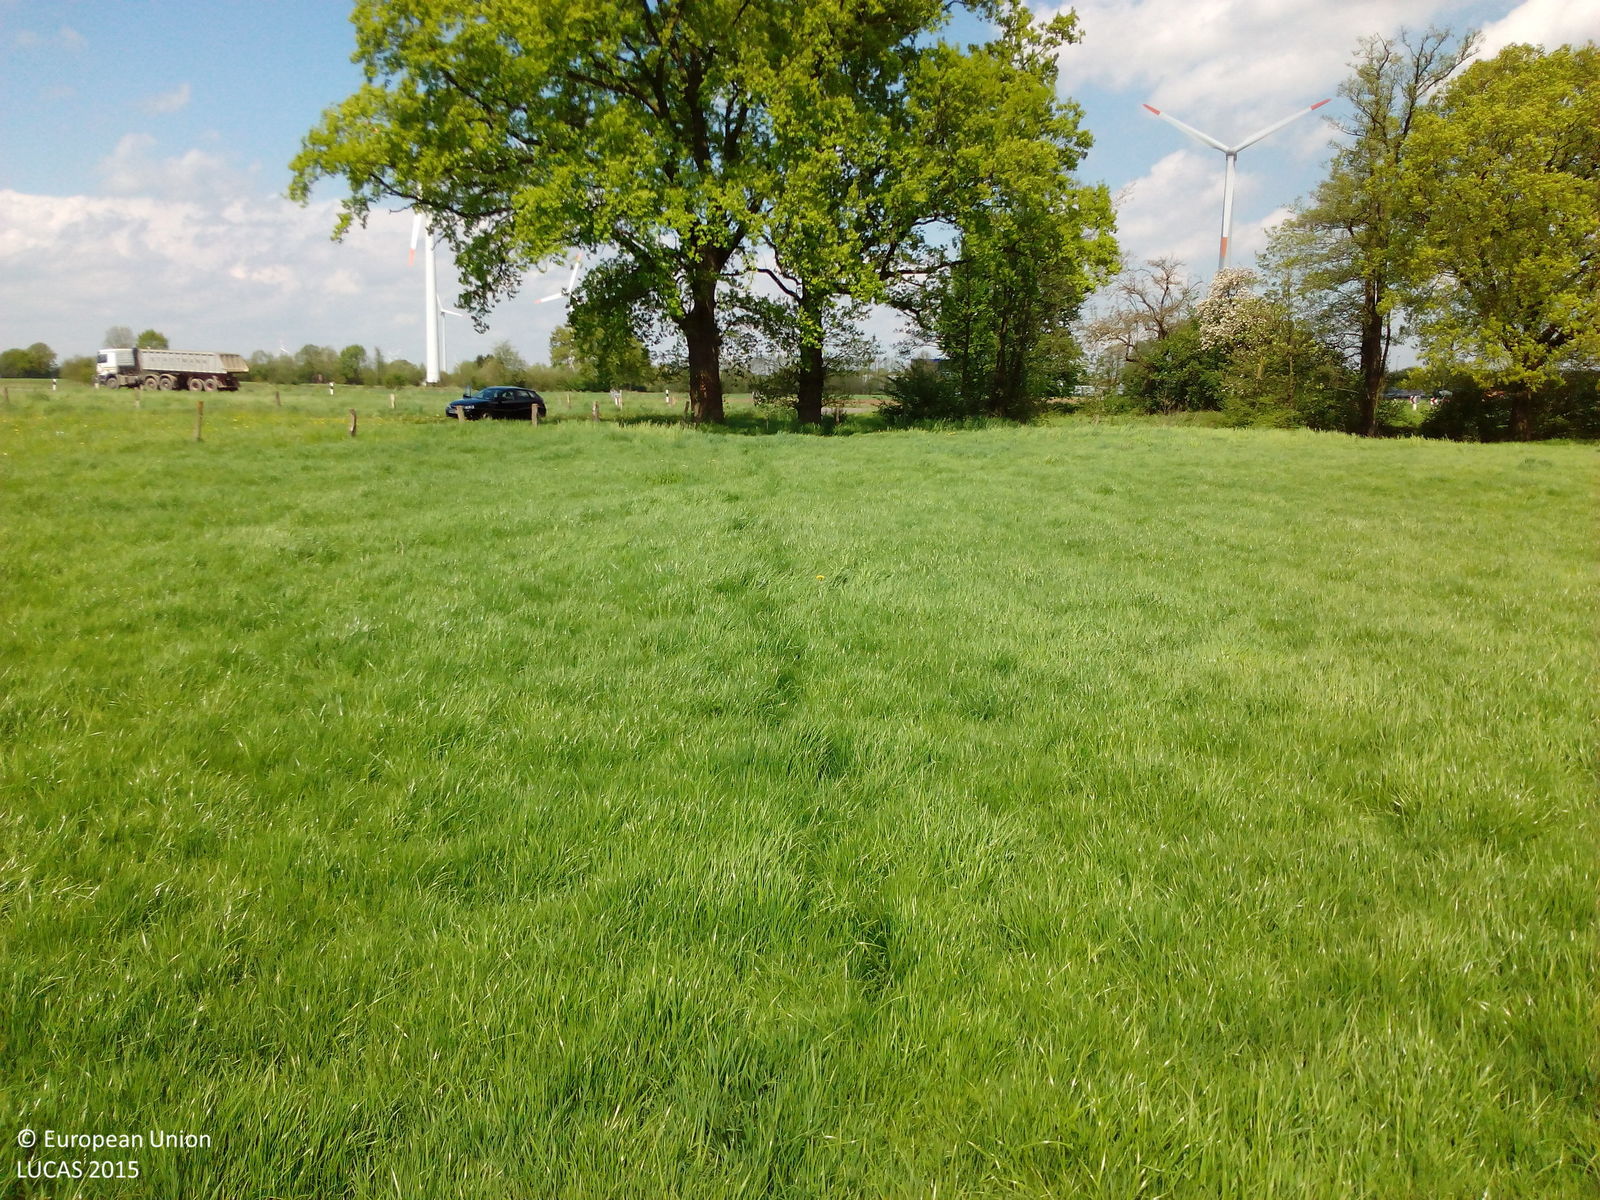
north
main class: Grassland
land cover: Grassland without tree/shrub cover
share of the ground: > 75 %
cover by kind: herbaceous plants 100 %
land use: Agriculture (excluding fallow land and kitchen gardens)
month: May
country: DE
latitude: 52.0264
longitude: 7.4498
